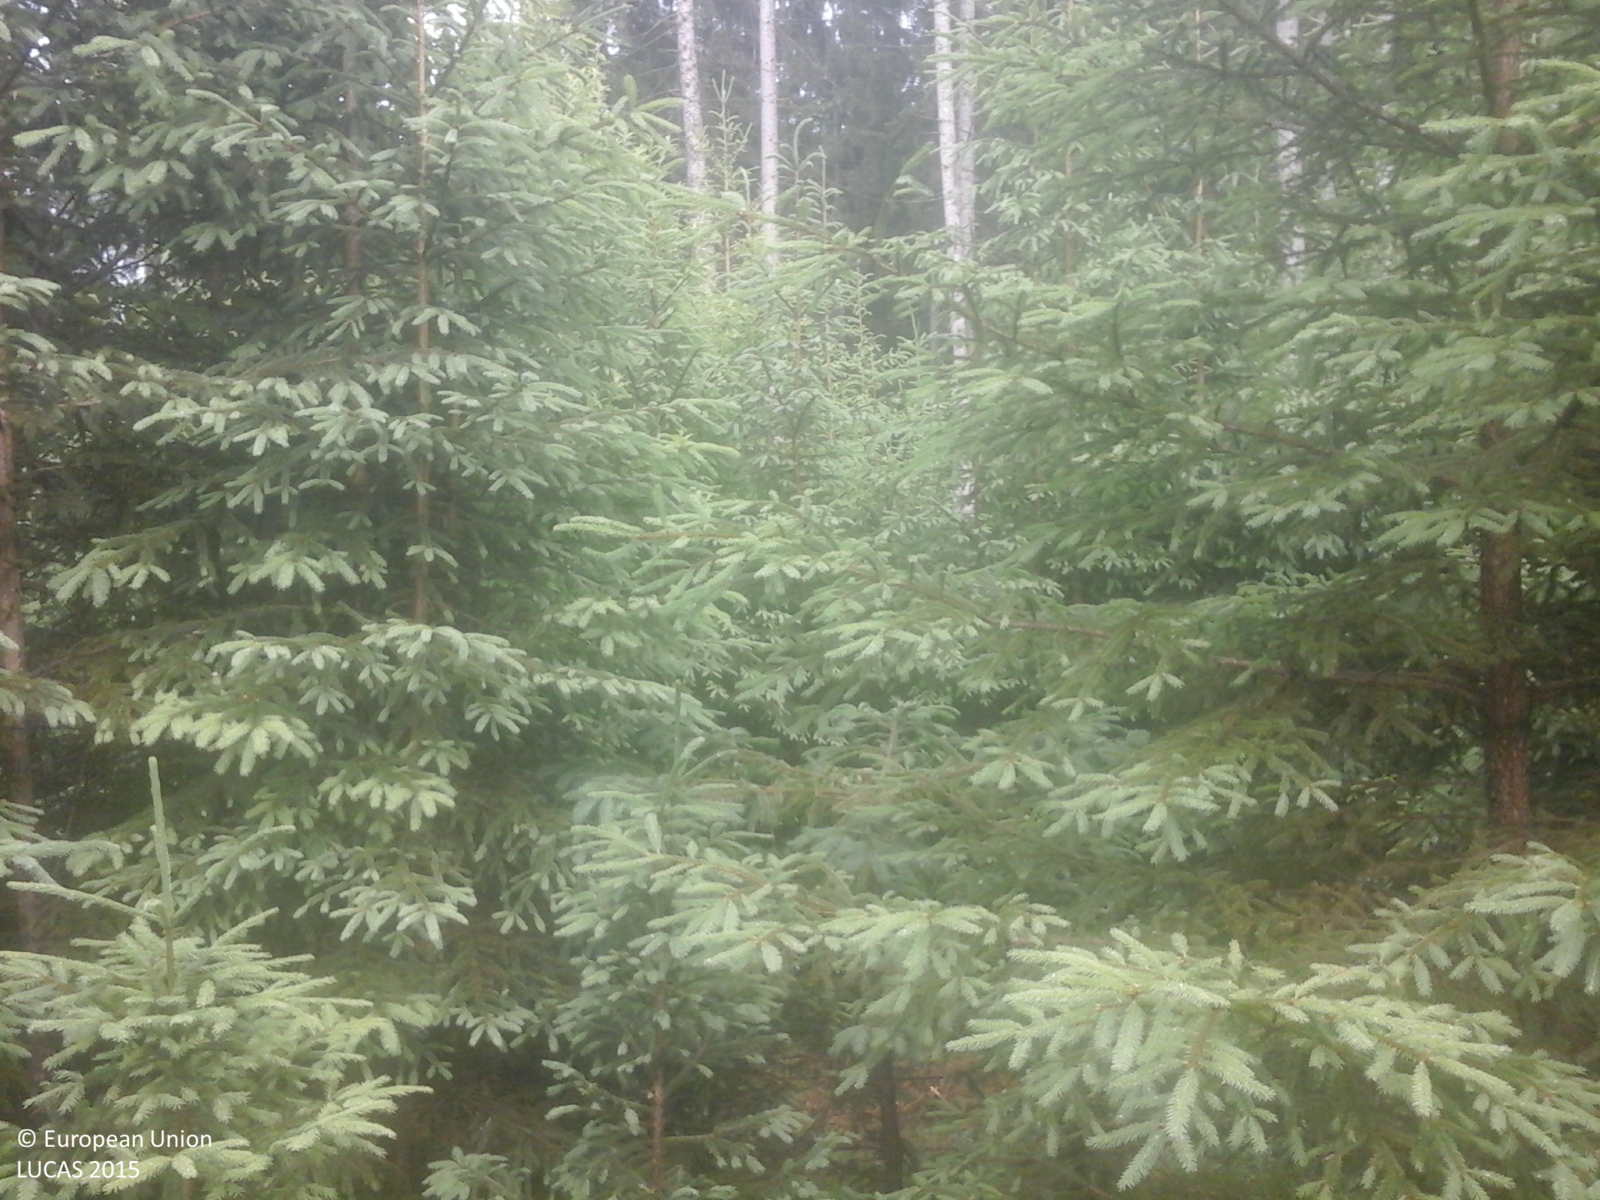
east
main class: Woodland
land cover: Spruce dominated coniferous woodland
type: alpine coniferous forest
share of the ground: > 75 %
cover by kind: coniferous forest trees 85 %, herbaceous plants 15 %
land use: Forestry
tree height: > 5 m
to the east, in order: Spruce dominated coniferous woodland; Tracks; Grass margins; Ditches and canals; Grass margins; Fences; Other leguminous and mixtures for fodder; Fences; Apple fruit; Artificial constructions in urban areas
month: June
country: RO
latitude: 47.5351
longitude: 25.7853
